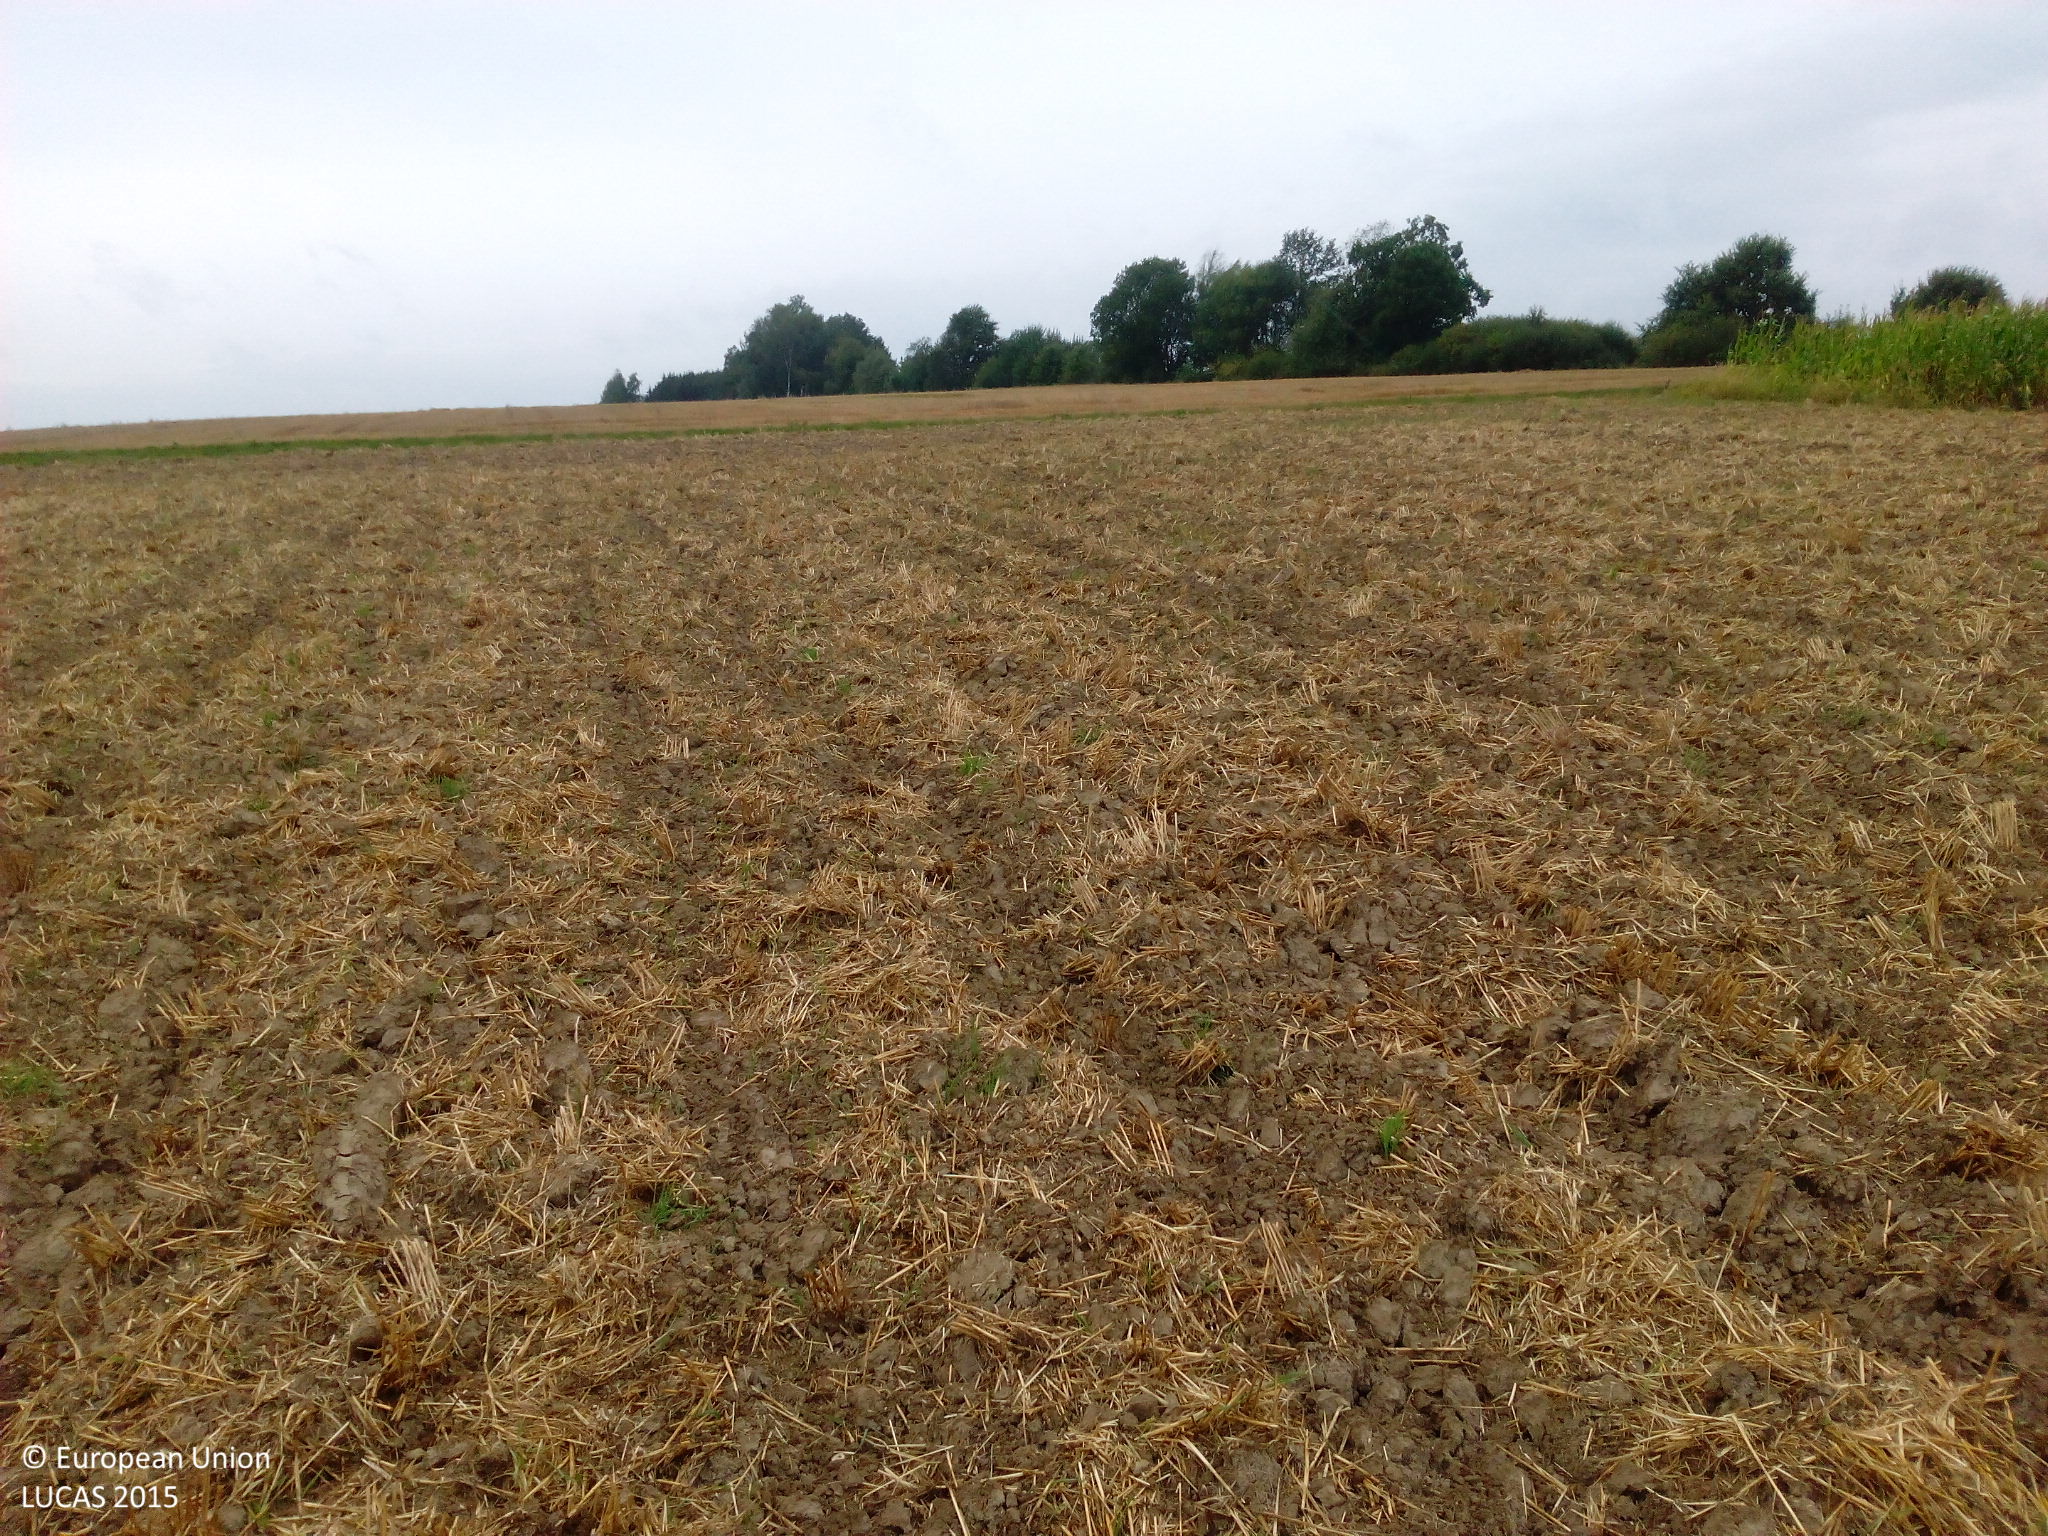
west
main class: Cropland
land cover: Common wheat
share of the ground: < 10 %
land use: Agriculture (excluding fallow land and kitchen gardens)
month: September
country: DE
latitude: 48.2952
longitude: 10.2560
